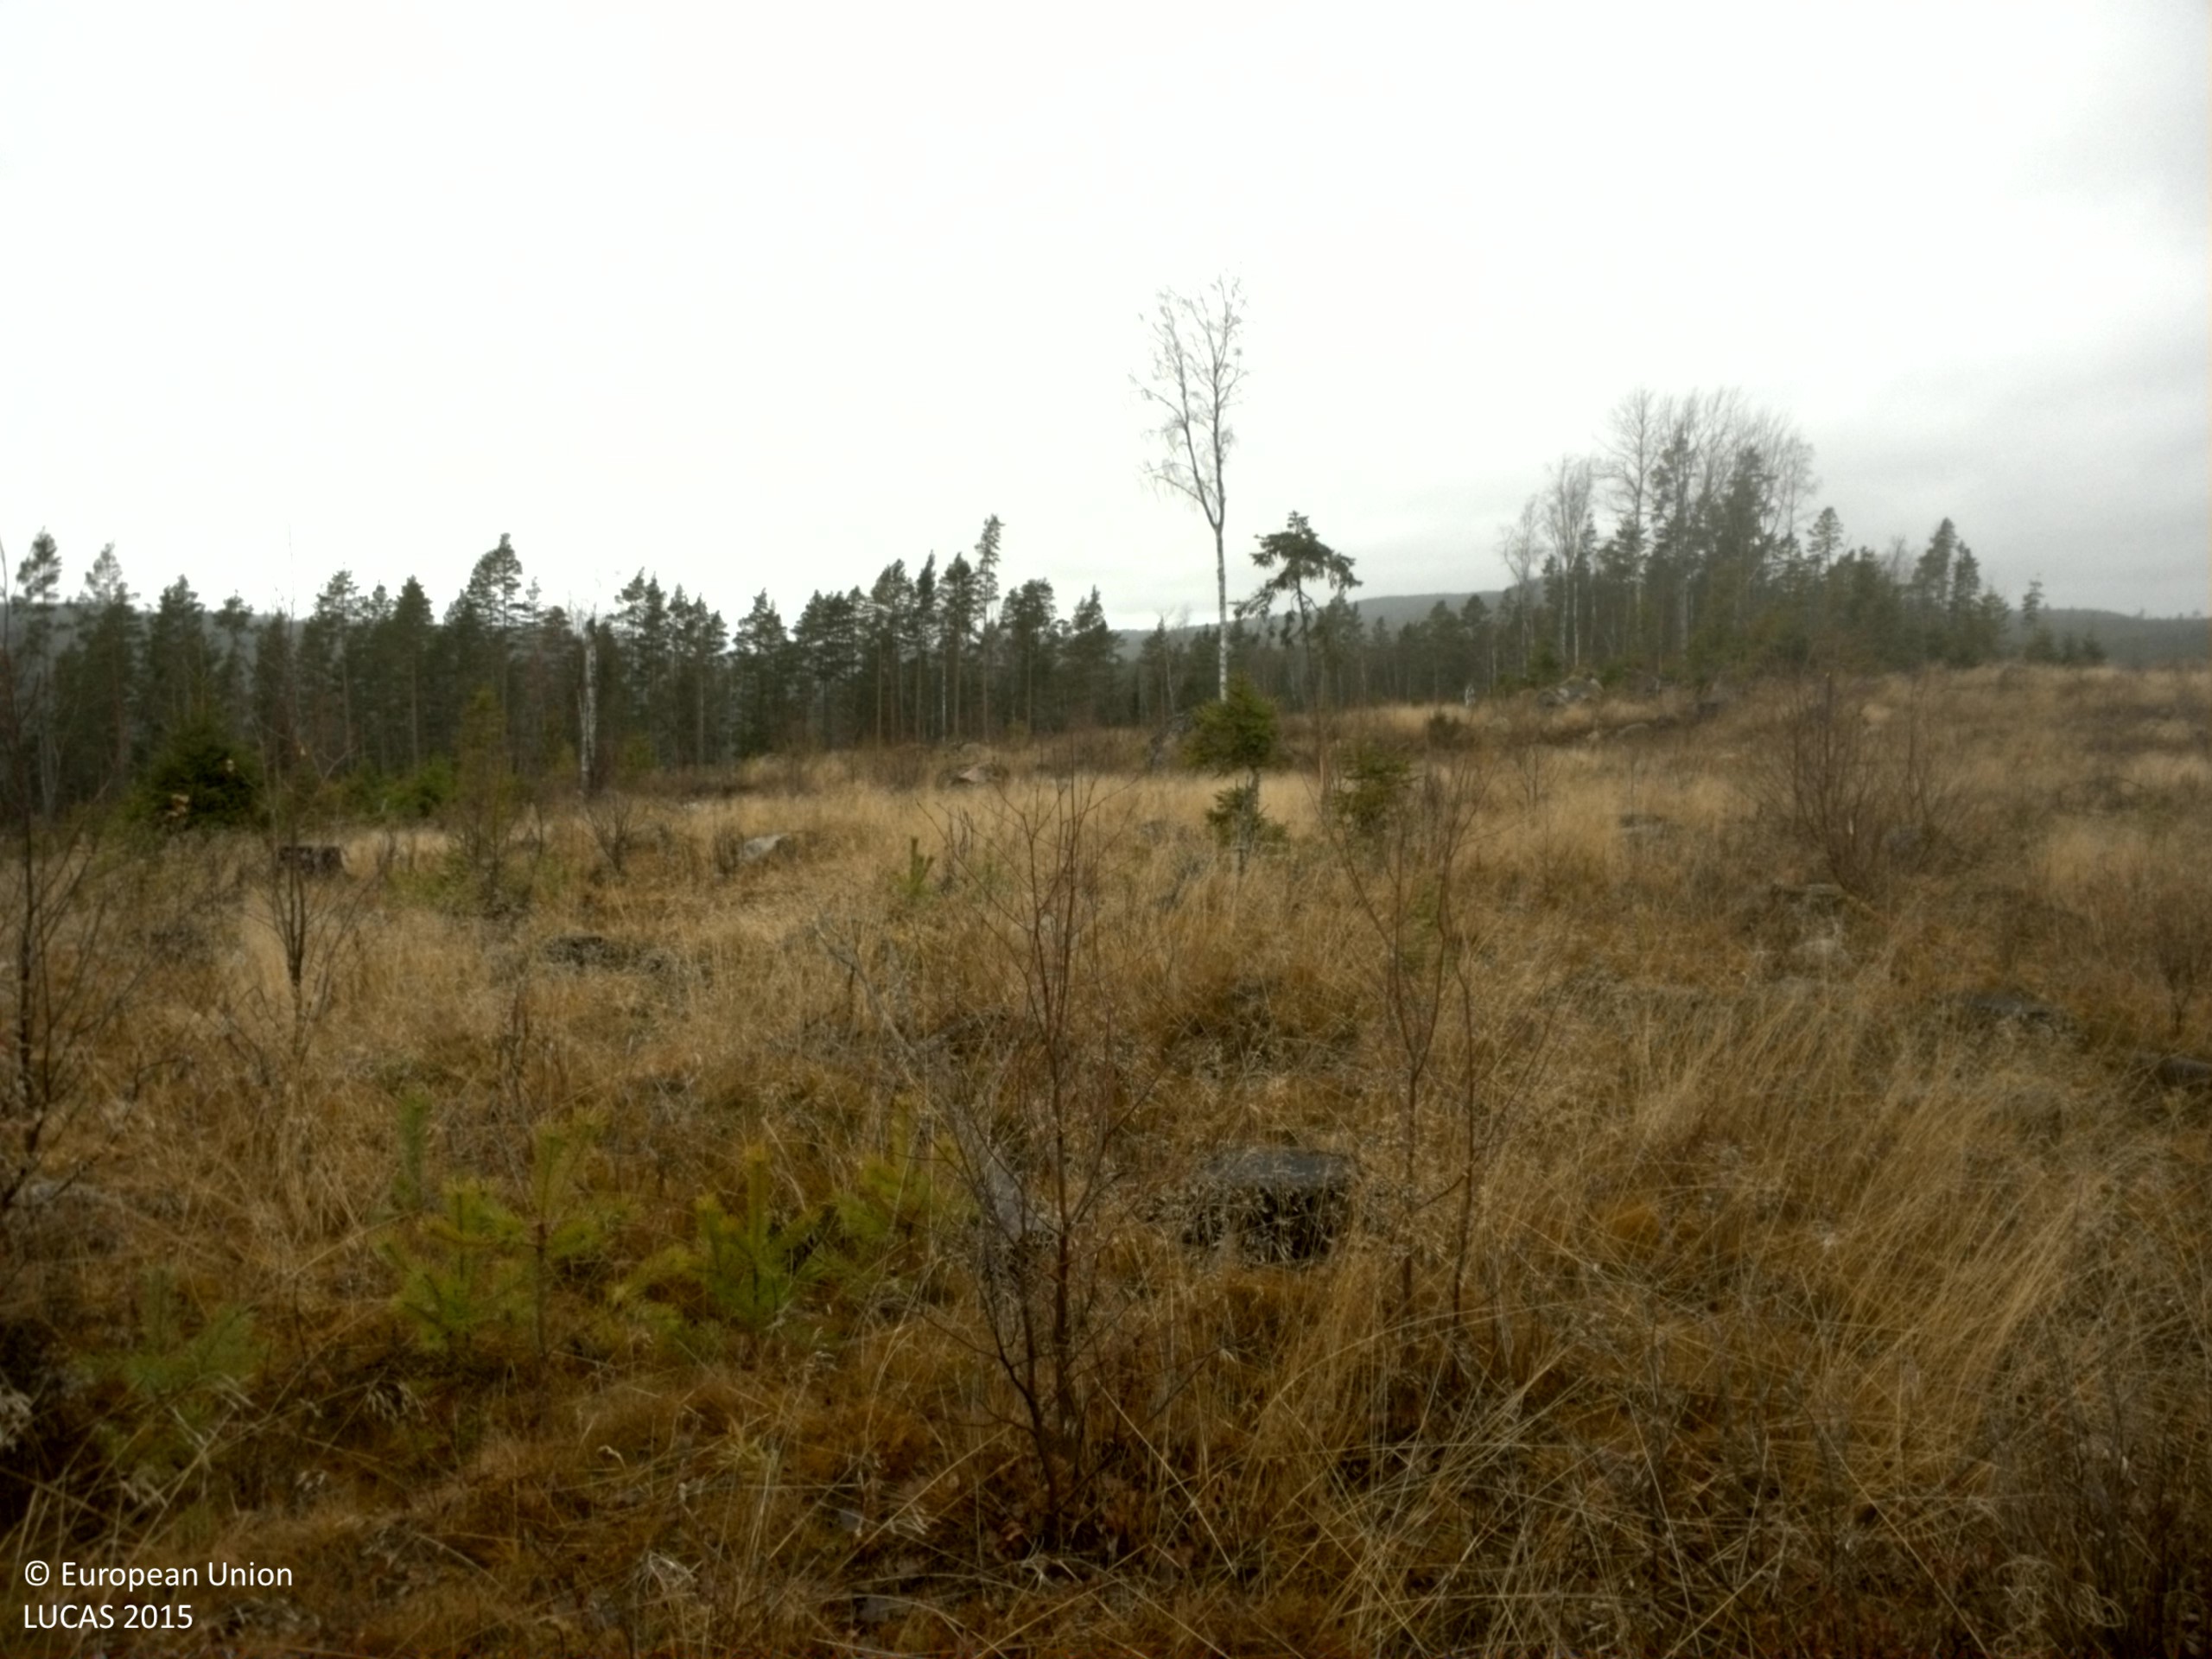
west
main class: Woodland
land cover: Other mixed woodland
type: boreal forest
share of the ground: 10 - 25 %
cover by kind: herbaceous plants 40 %, lichens and mosses 20 %, shrubs 15 %, coniferous forest trees 10 %, broadleaved forest trees 10 %, consolidated bare surface 5 %
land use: Forestry
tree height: < 5 m
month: November
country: SE
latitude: 61.6009
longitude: 16.5616
